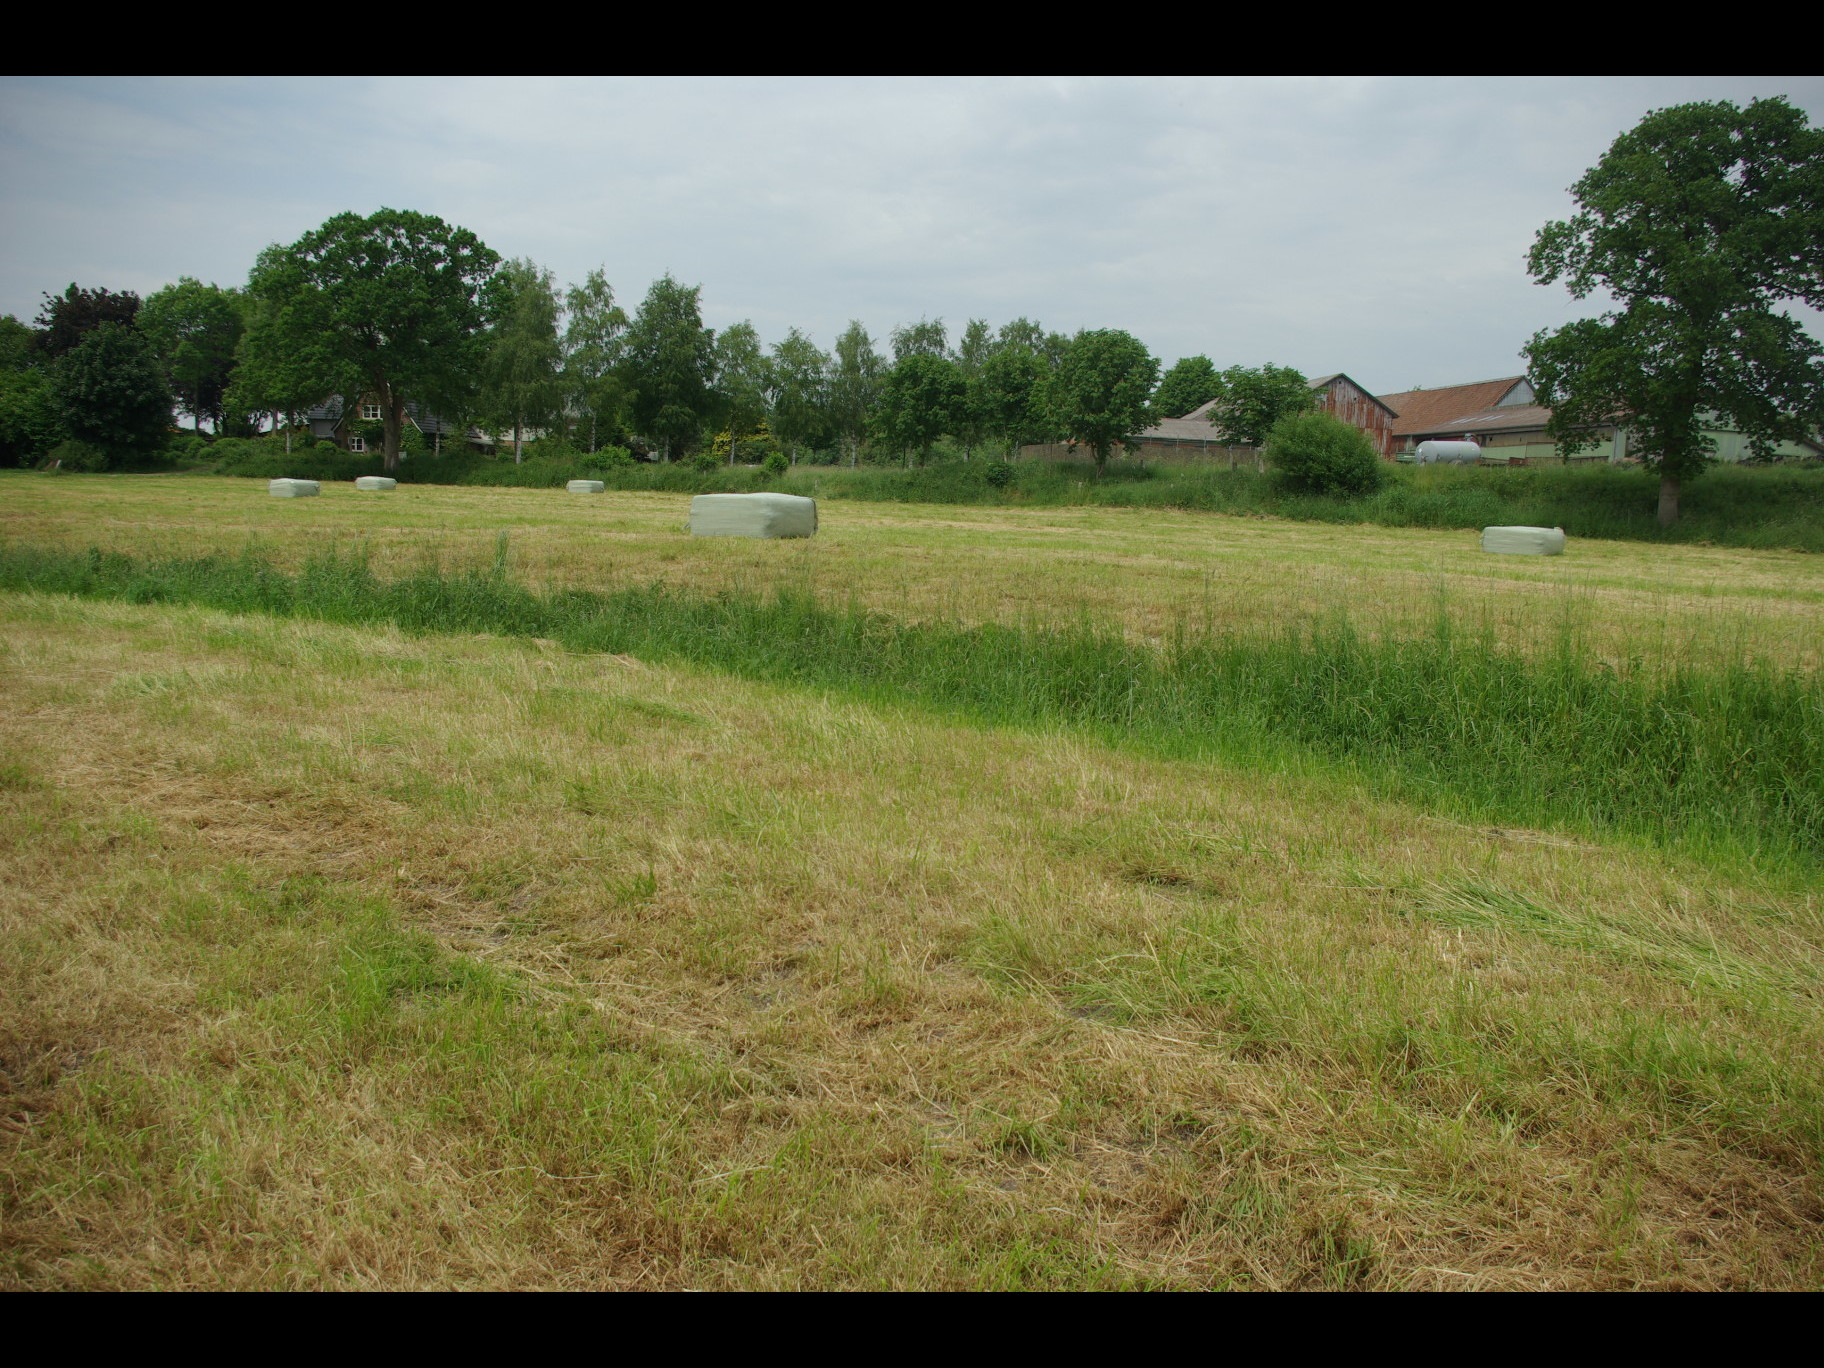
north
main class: Grassland
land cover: Grassland without tree/shrub cover
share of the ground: > 75 %
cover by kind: herbaceous plants 100 %
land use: Agriculture (excluding fallow land and kitchen gardens)
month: June
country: DE
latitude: 54.4083
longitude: 9.8922
